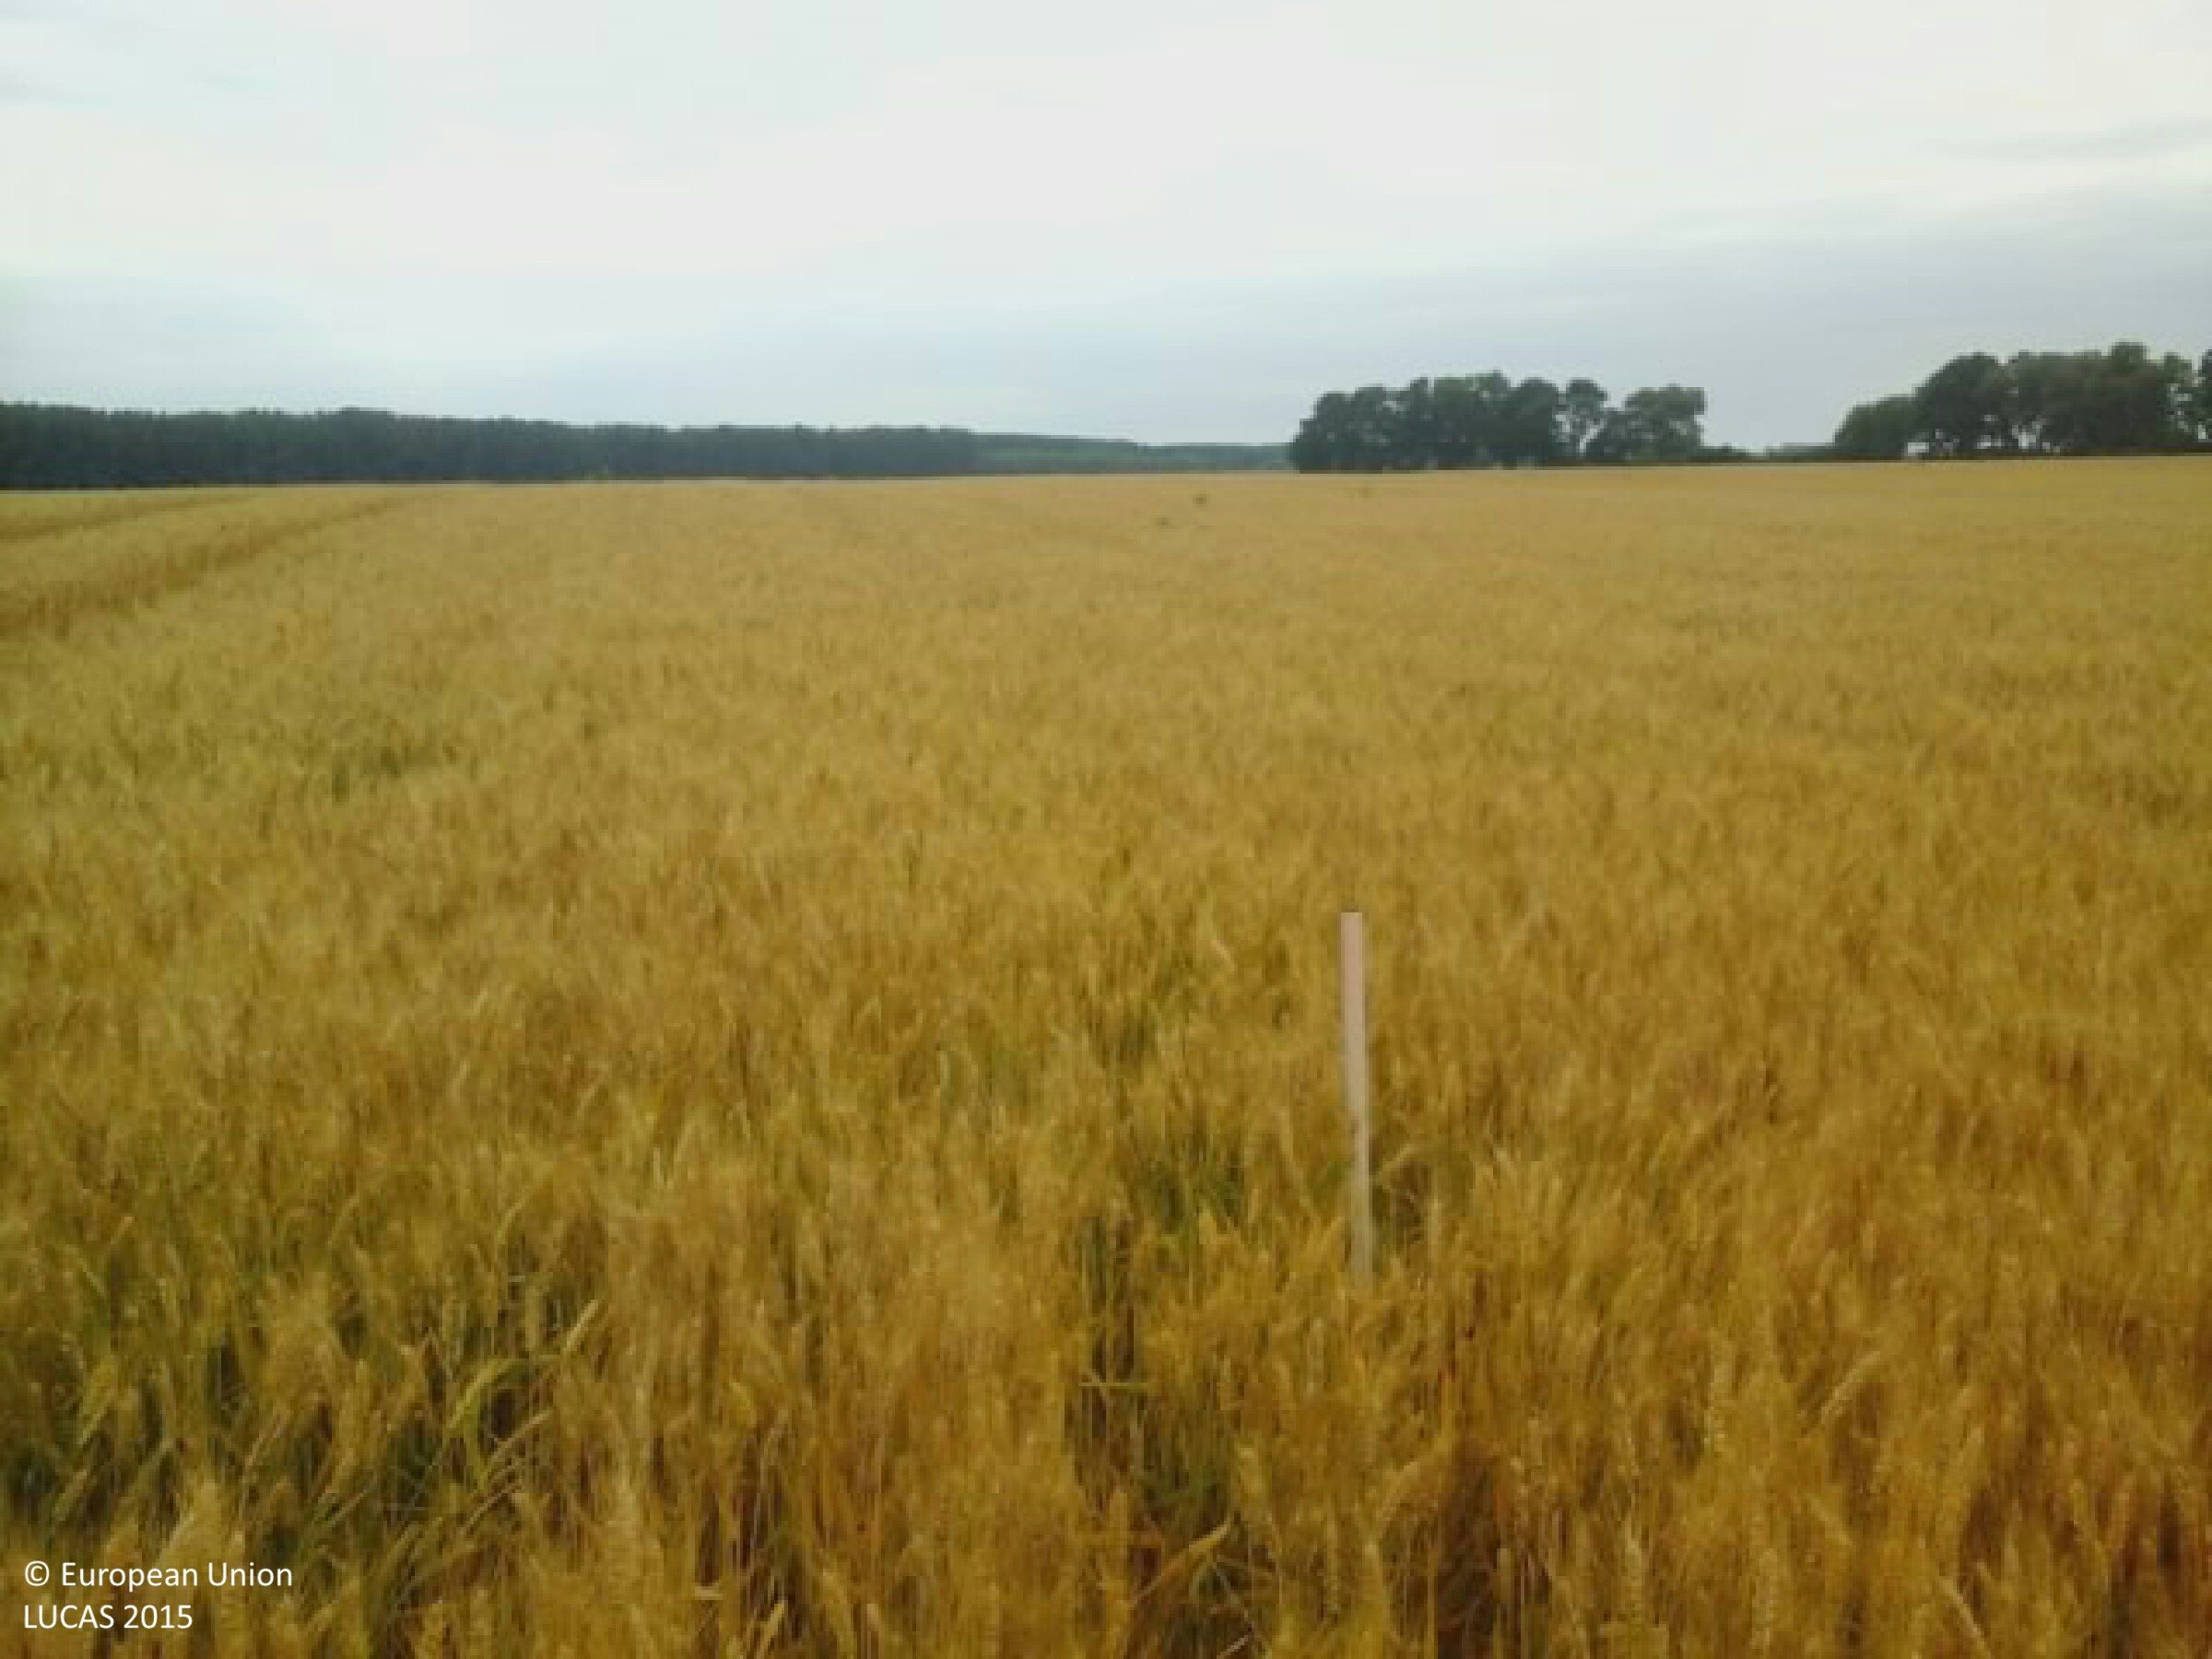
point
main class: Cropland
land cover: Common wheat
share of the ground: > 75 %
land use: Agriculture (excluding fallow land and kitchen gardens)
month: June
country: HU
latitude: 46.3409
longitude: 18.9122
